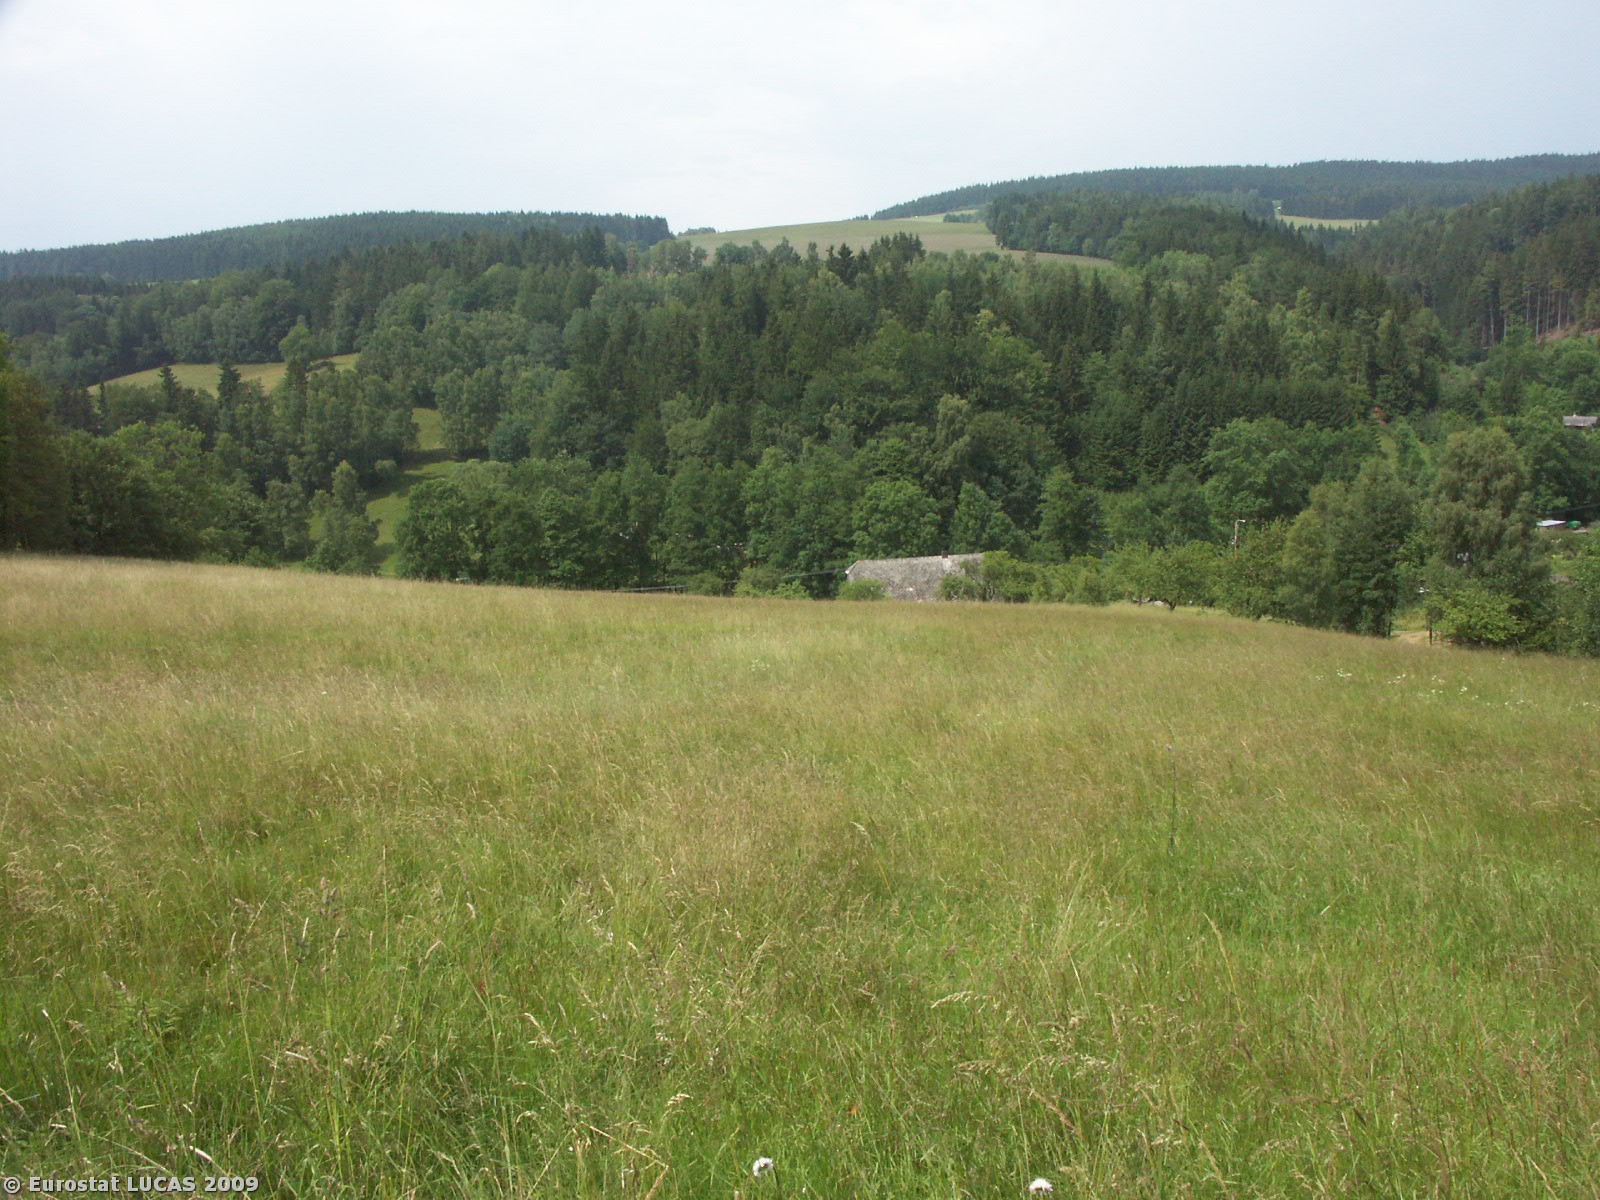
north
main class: Grassland
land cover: Grassland without tree/shrub cover
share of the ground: > 75 %
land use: Agriculture (excluding fallow land and kitchen gardens)
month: July
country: CZ
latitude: 50.0252
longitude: 16.6664
